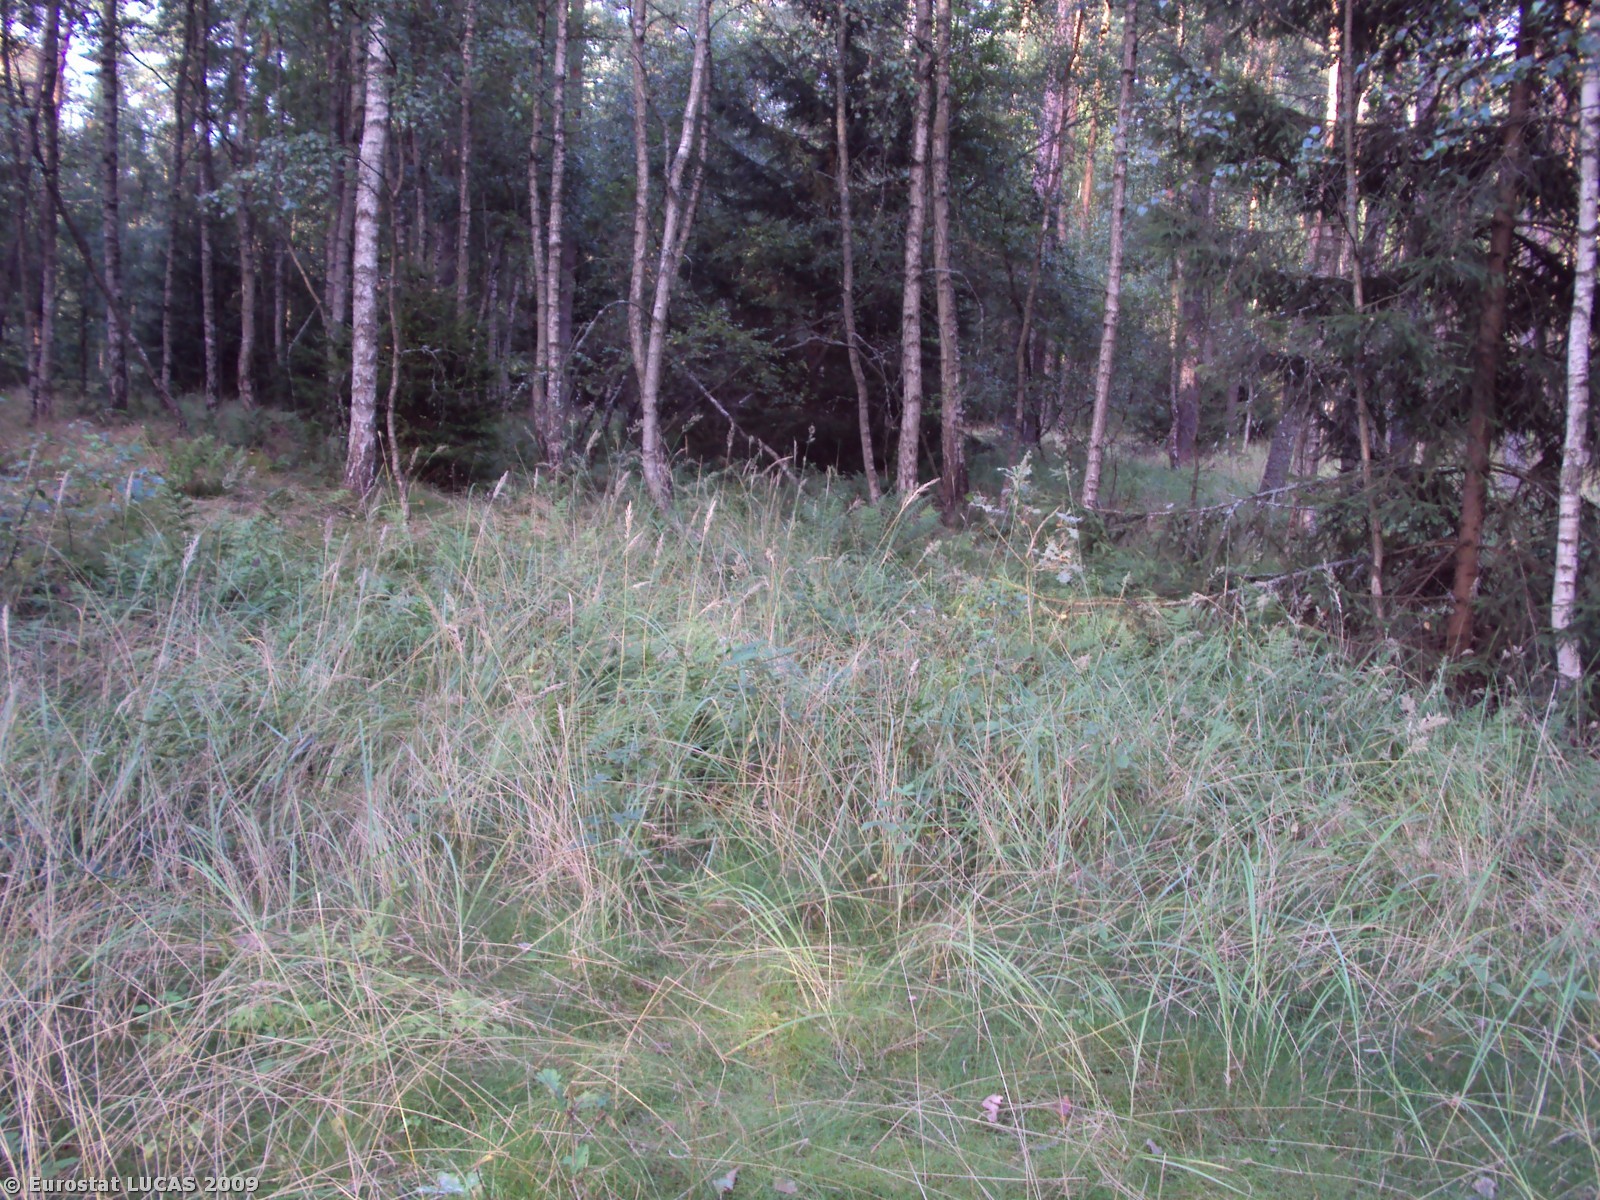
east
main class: Woodland
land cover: Mixed woodland
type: hemiboreal forest and nemoral coniferous forest and mixed broadleaved-coniferous forest
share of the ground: > 75 %
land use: Forestry
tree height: > 5 m
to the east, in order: Mixed woodland
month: August
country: PL
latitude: 53.4165
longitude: 15.9781
